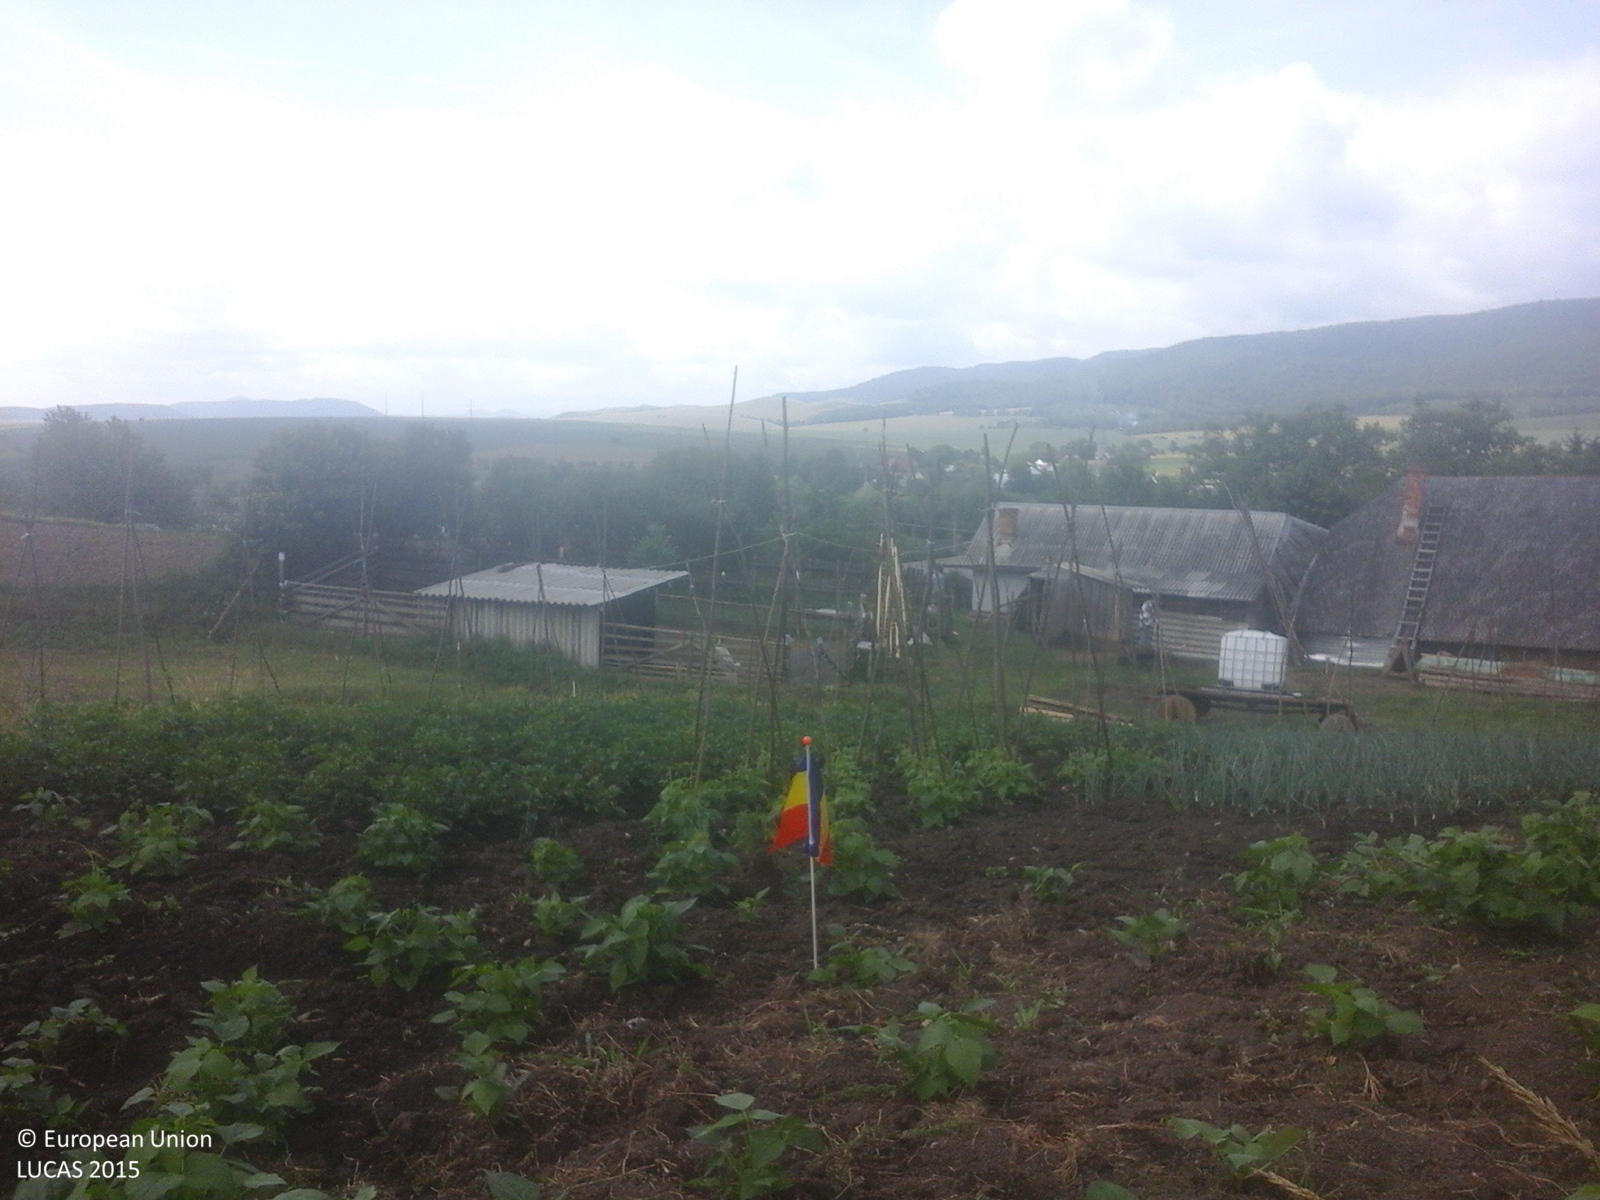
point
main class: Cropland
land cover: Dry pulses
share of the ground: < 10 %
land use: Kitchen garden
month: June
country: RO
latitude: 47.0448
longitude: 26.3637
